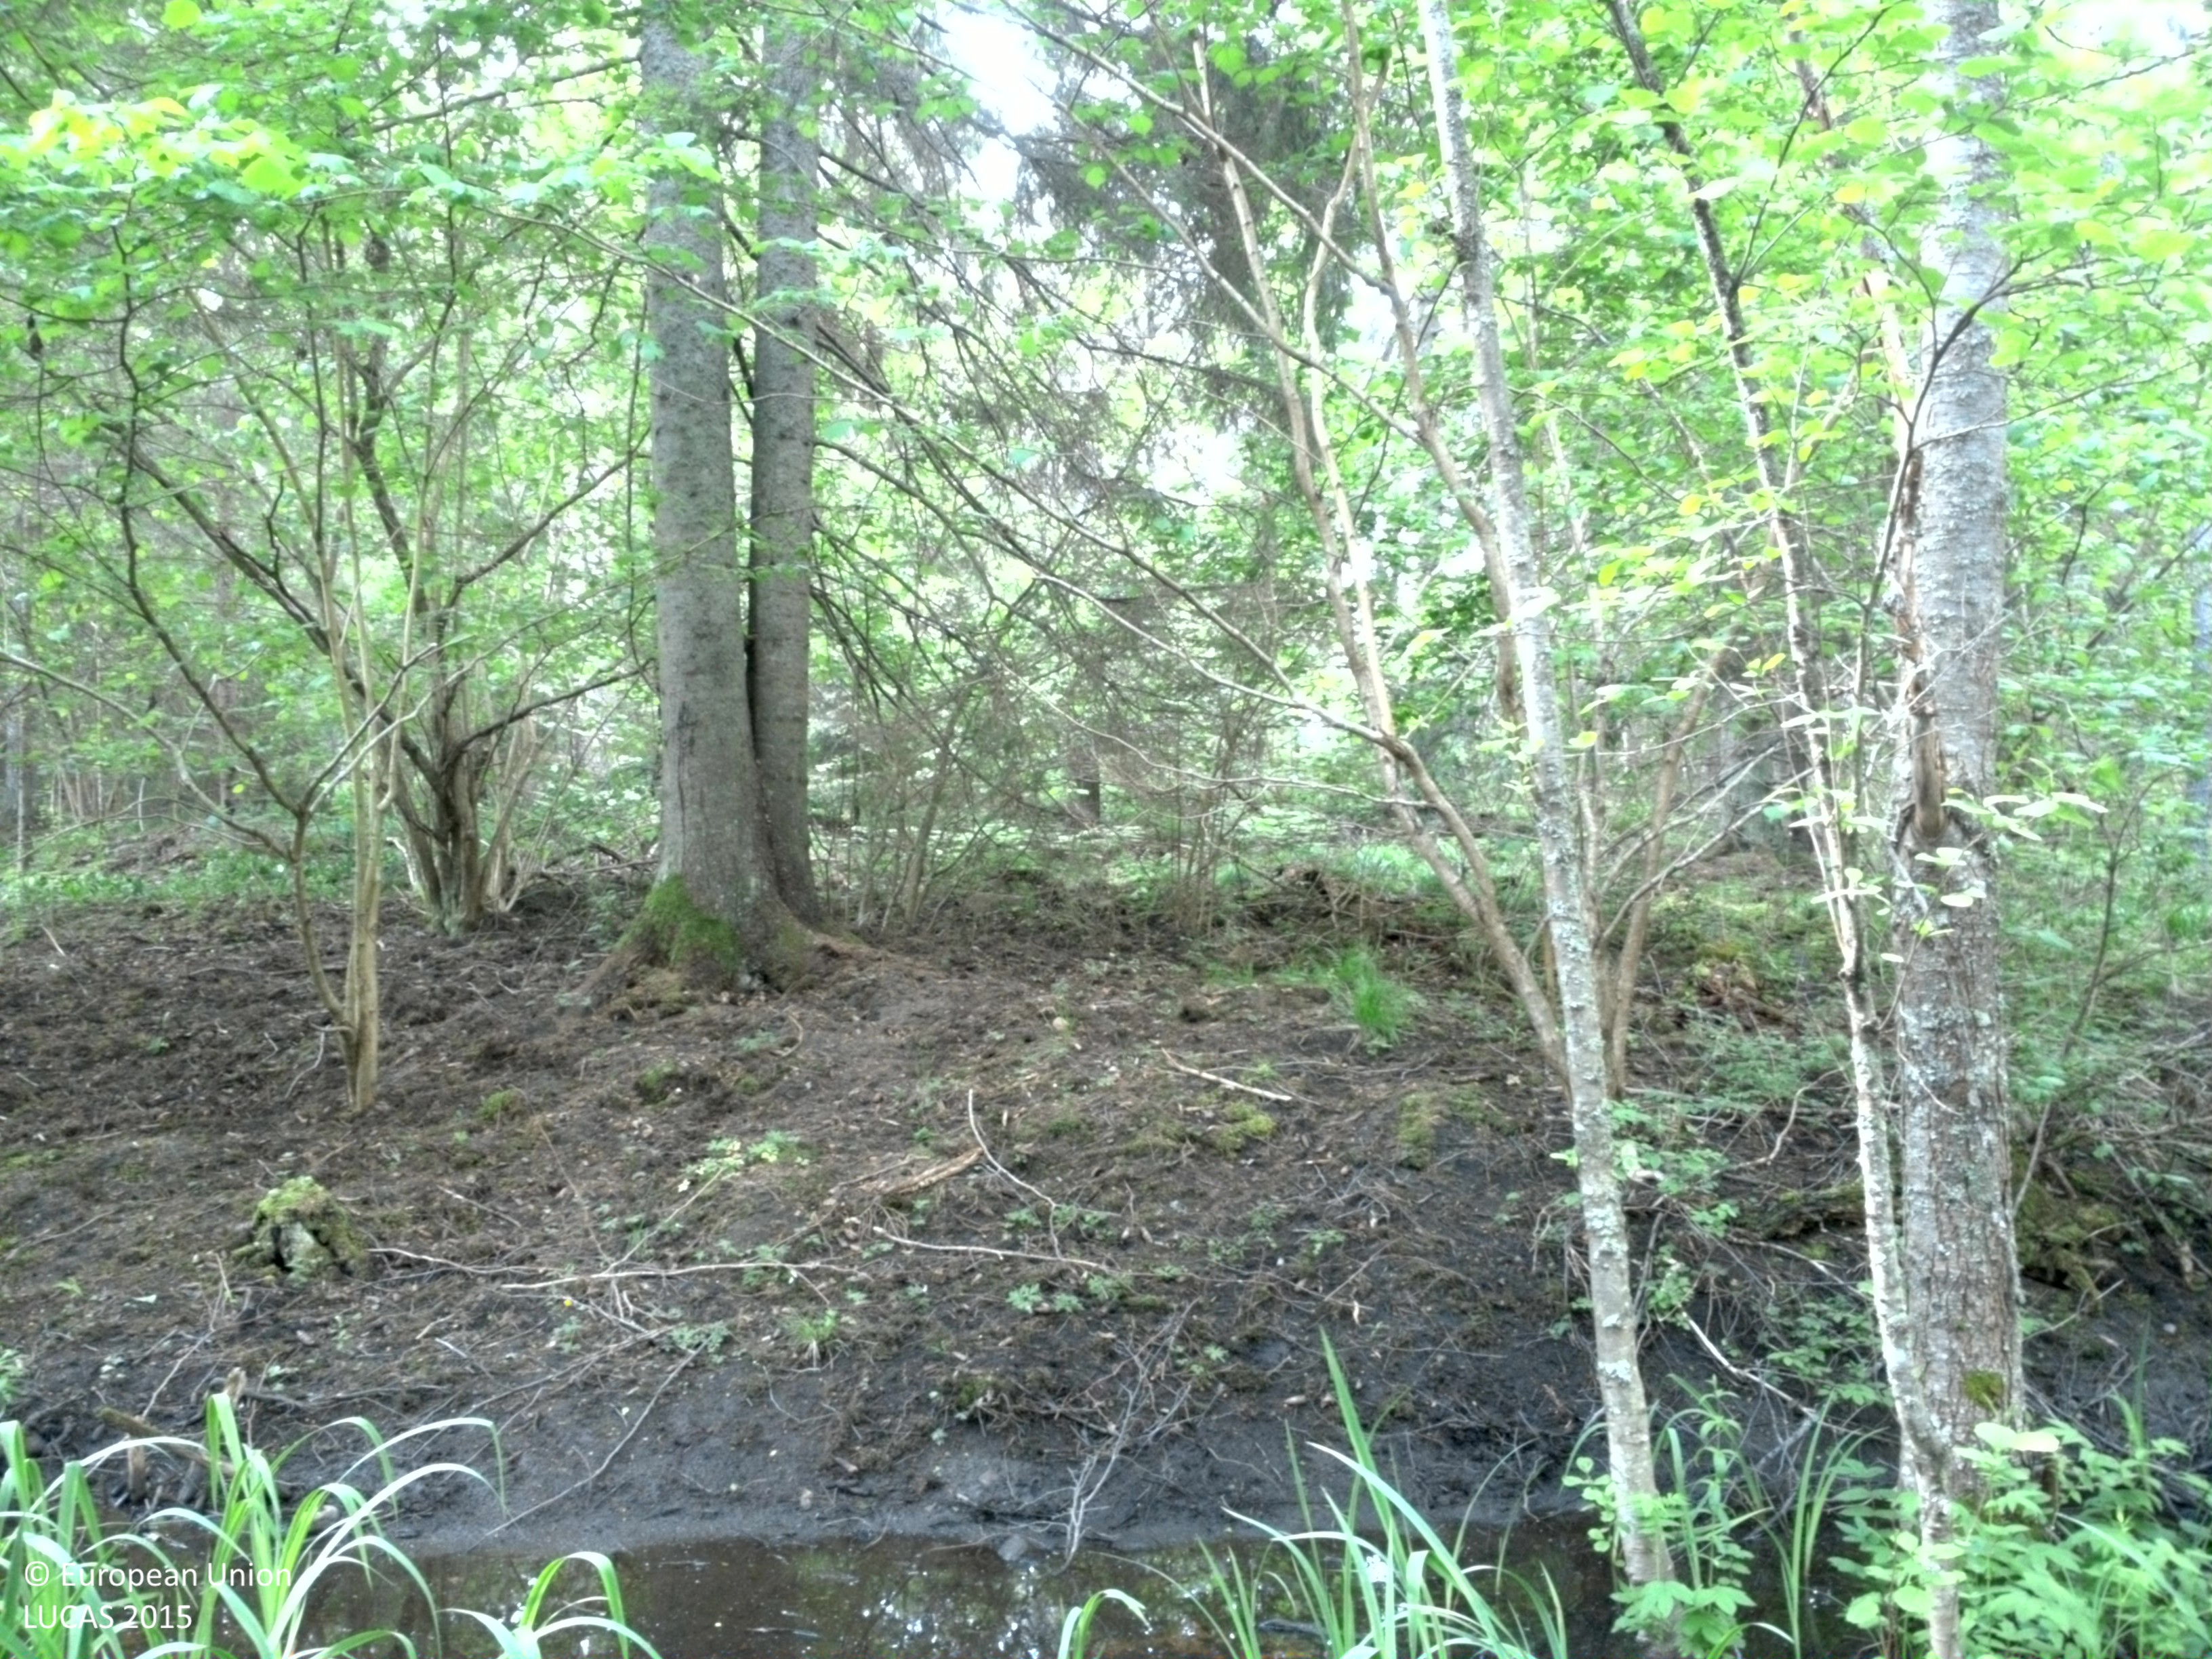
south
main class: Woodland
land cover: Spruce dominated mixed woodland
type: boreal forest
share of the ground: > 75 %
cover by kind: coniferous forest trees 60 %, broadleaved forest trees 20 %, herbaceous plants 10 %, lichens and mosses 10 %
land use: Forestry
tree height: > 5 m
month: June
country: SE
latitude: 60.0895
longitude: 18.7542
